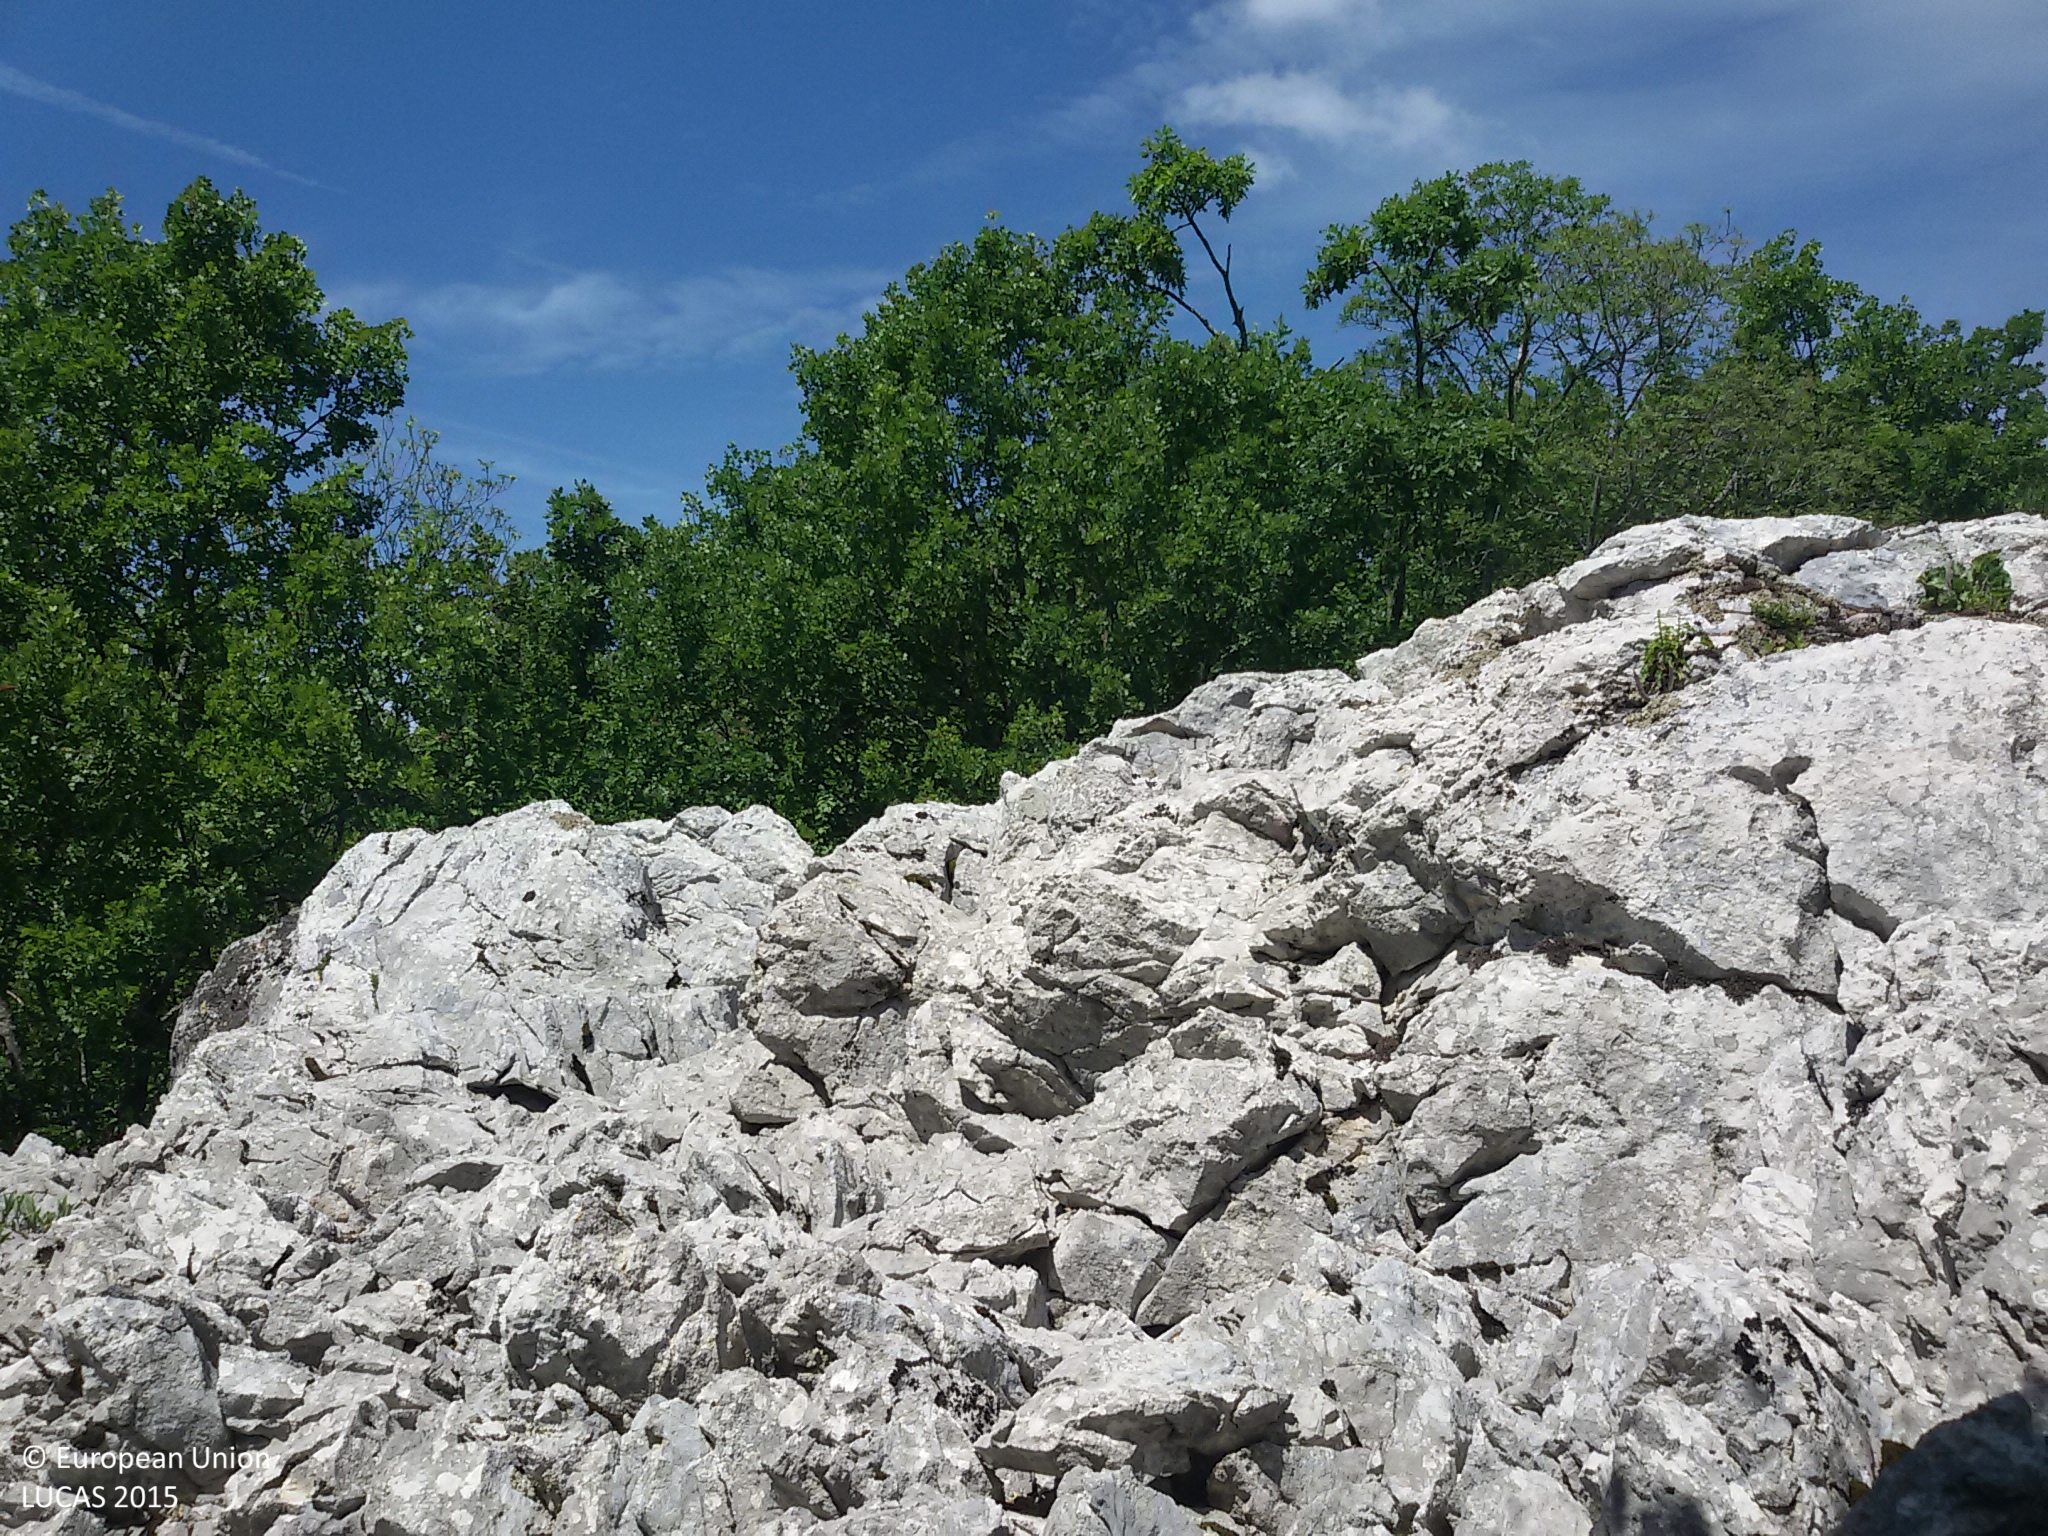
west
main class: Woodland
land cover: Broadleaved woodland
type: mountainous beech forest
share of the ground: 50 - 75 %
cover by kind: broadleaved forest trees 50 %, consolidated bare surface 20 %, shrubs 10 %, lichens and mosses 10 %, herbaceous plants 5 %, unconsolidated bare surface 5 %
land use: Semi-natural and natural areas not in use
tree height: > 5 m
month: June
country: HR
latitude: 44.5610
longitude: 15.5962
